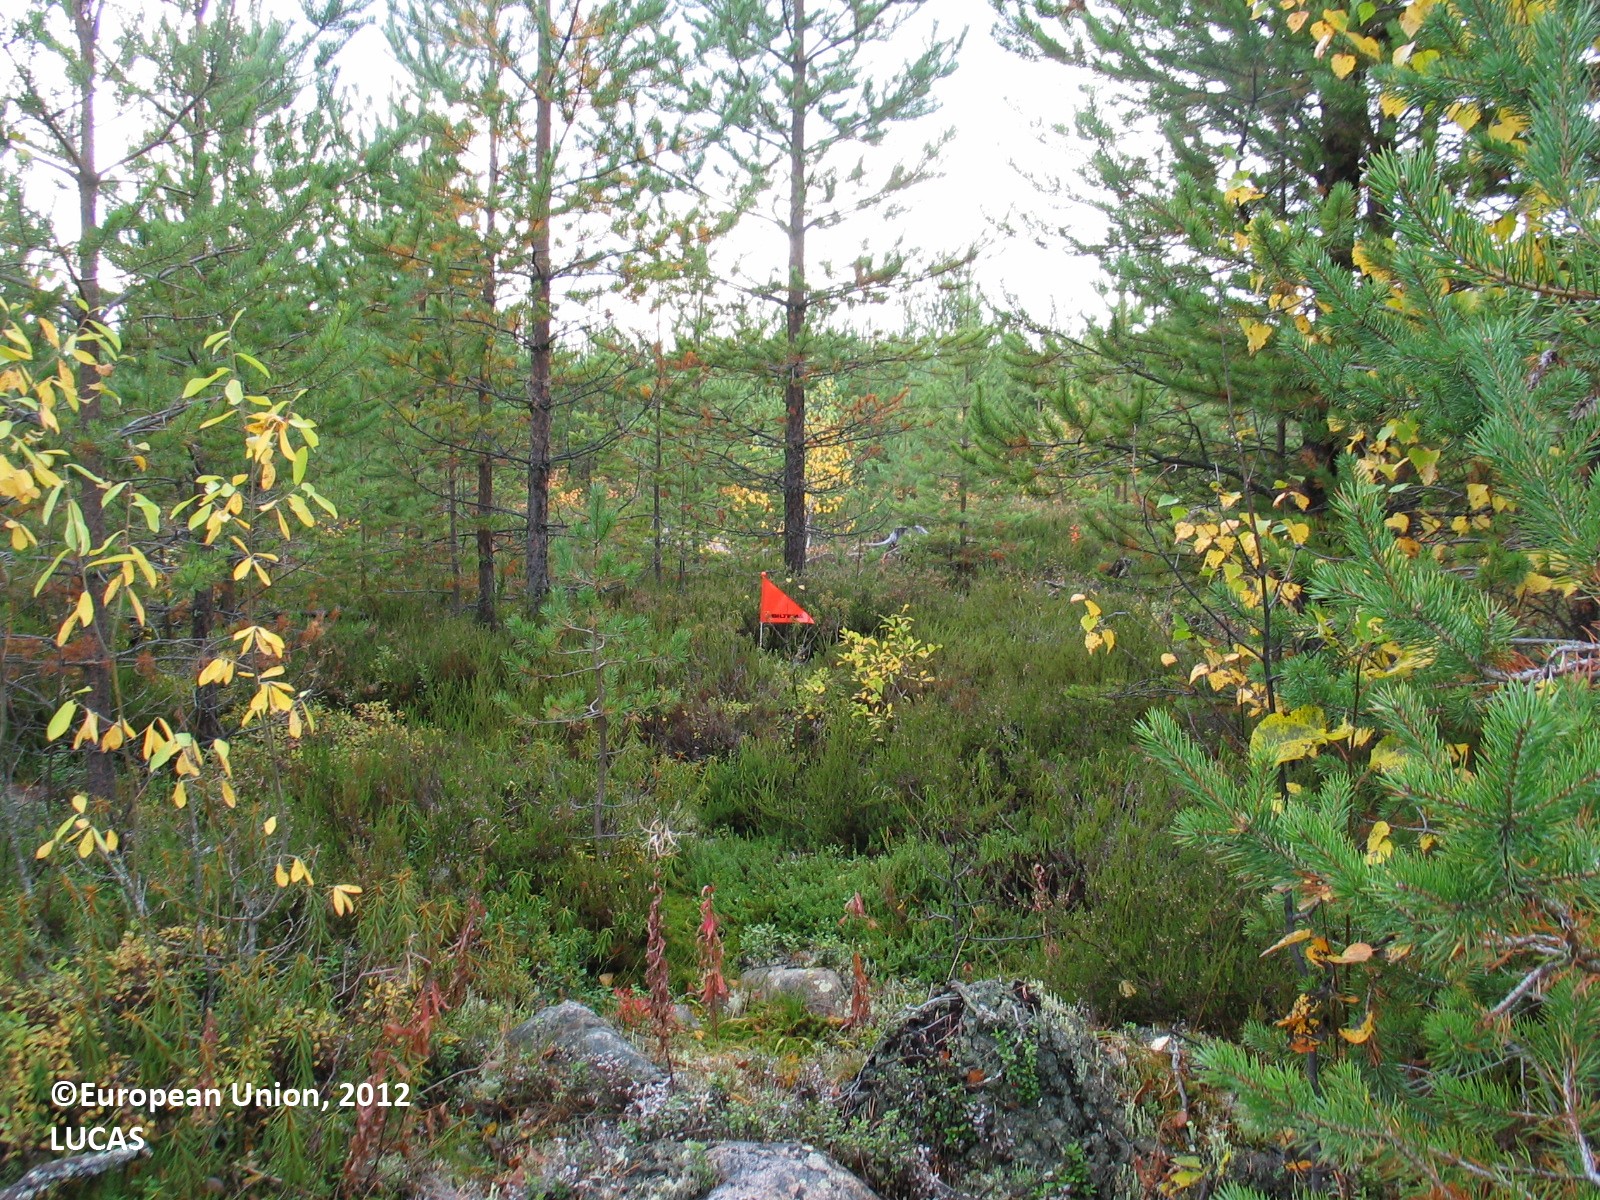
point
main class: Woodland
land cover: Pine dominated coniferous woodland
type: boreal forest
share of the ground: 25 - 50 %
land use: Forestry
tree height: < 5 m
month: September
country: FI
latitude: 65.3744
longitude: 25.6323
